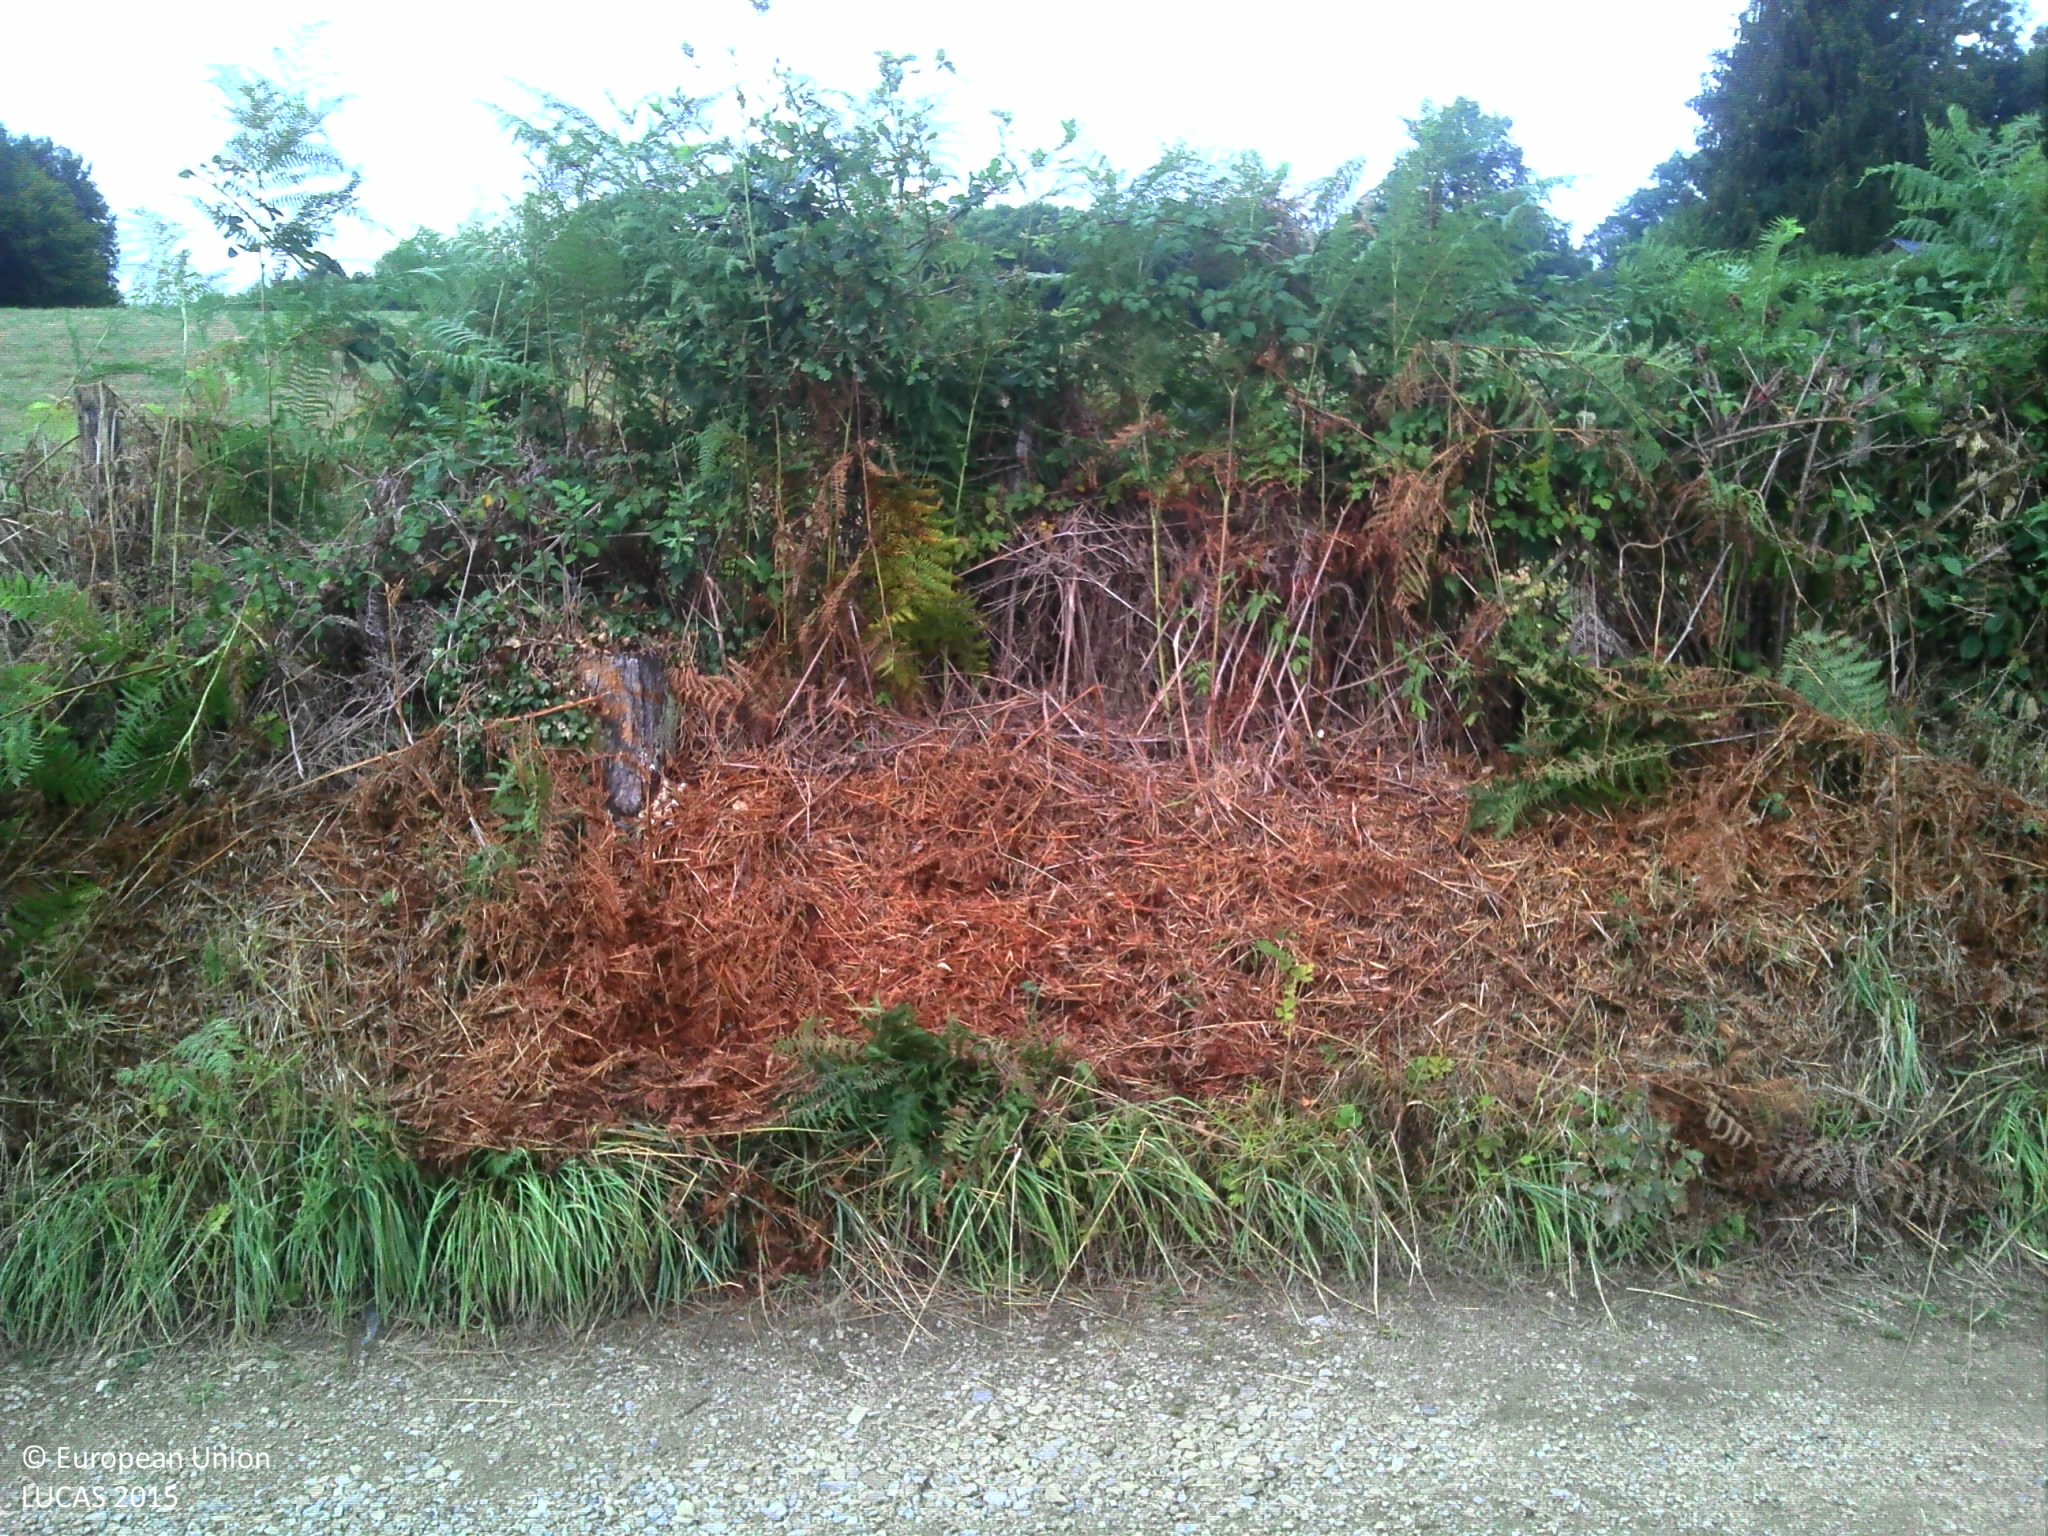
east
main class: Grassland
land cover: Grassland without tree/shrub cover
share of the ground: > 75 %
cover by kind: herbaceous plants 100 %
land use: Agriculture (excluding fallow land and kitchen gardens)
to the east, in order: Grassland without tree/shrub cover; Fences; Abandoned hedges; Grass margins; Tracks; Grass margins; Managed hedges; Fences; Grassland without tree/shrub cover
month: August
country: FR
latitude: 45.4645
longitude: 1.6687
